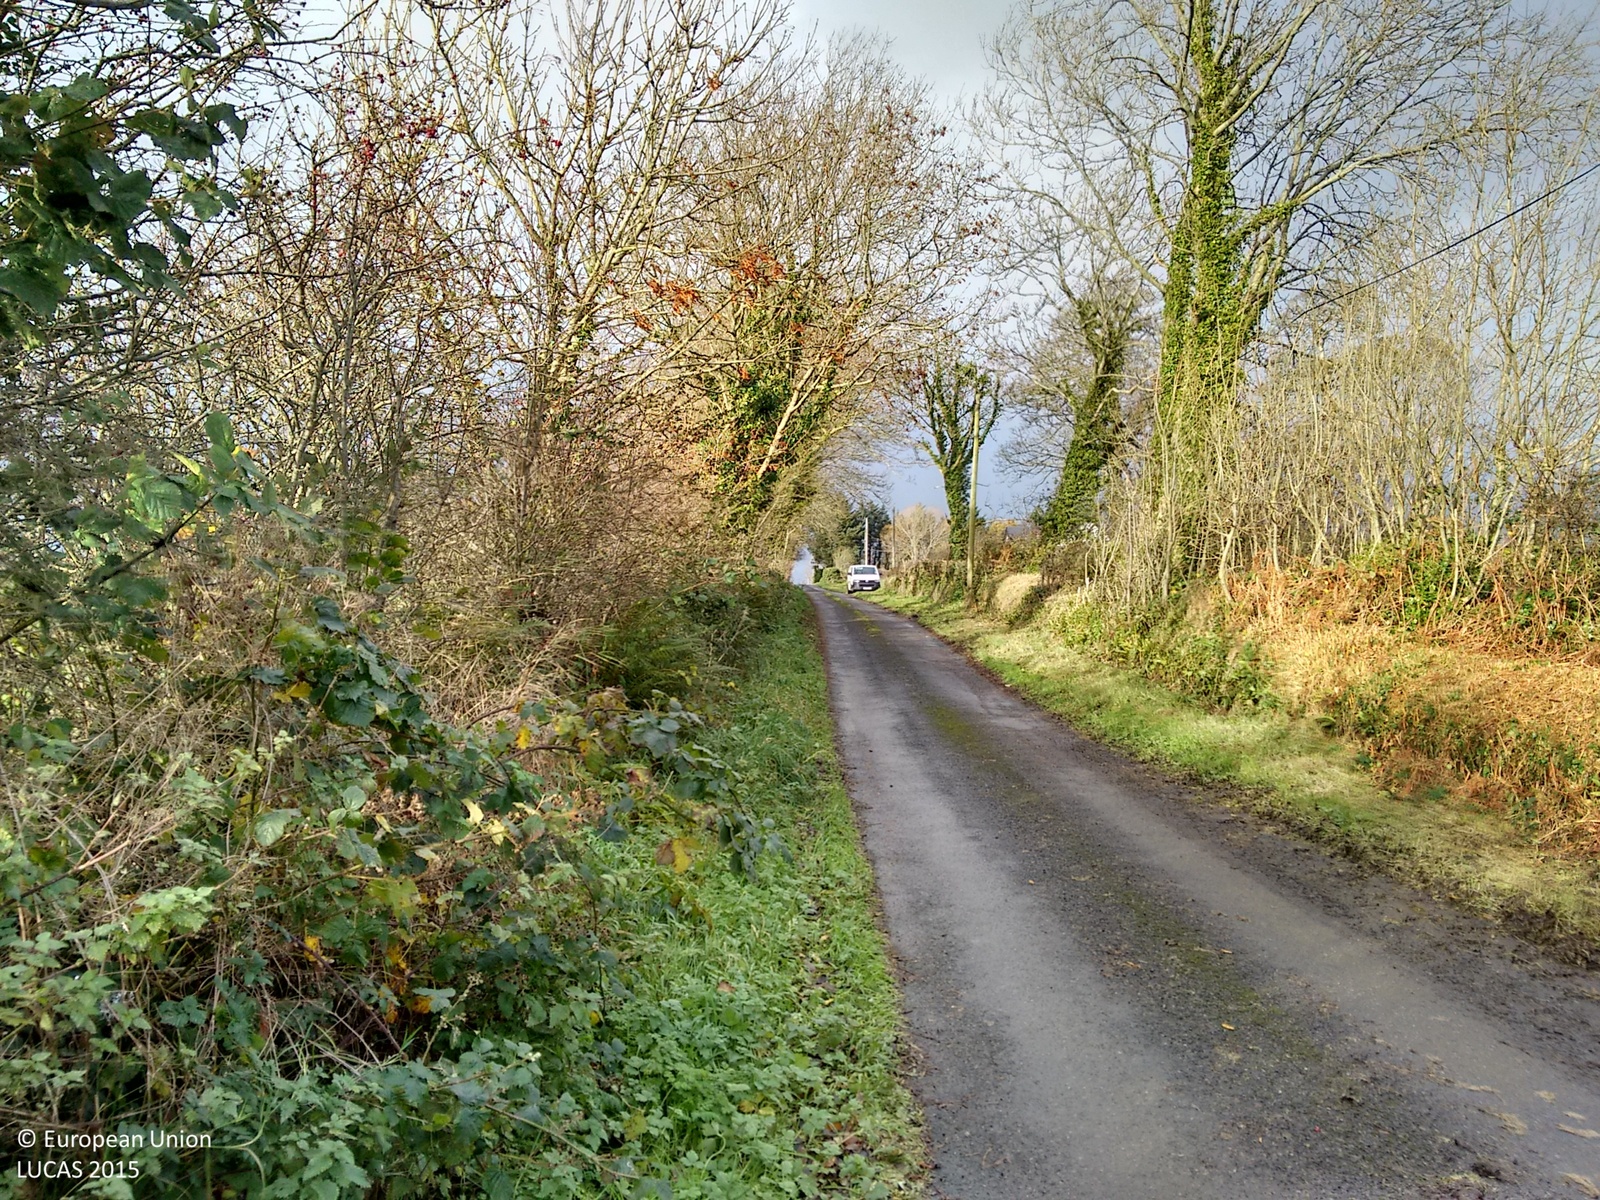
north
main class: Grassland
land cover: Grassland without tree/shrub cover
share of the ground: > 75 %
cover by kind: herbaceous plants 100 %
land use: Agriculture (excluding fallow land and kitchen gardens)
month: November
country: IE
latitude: 54.3535
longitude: -8.5493
